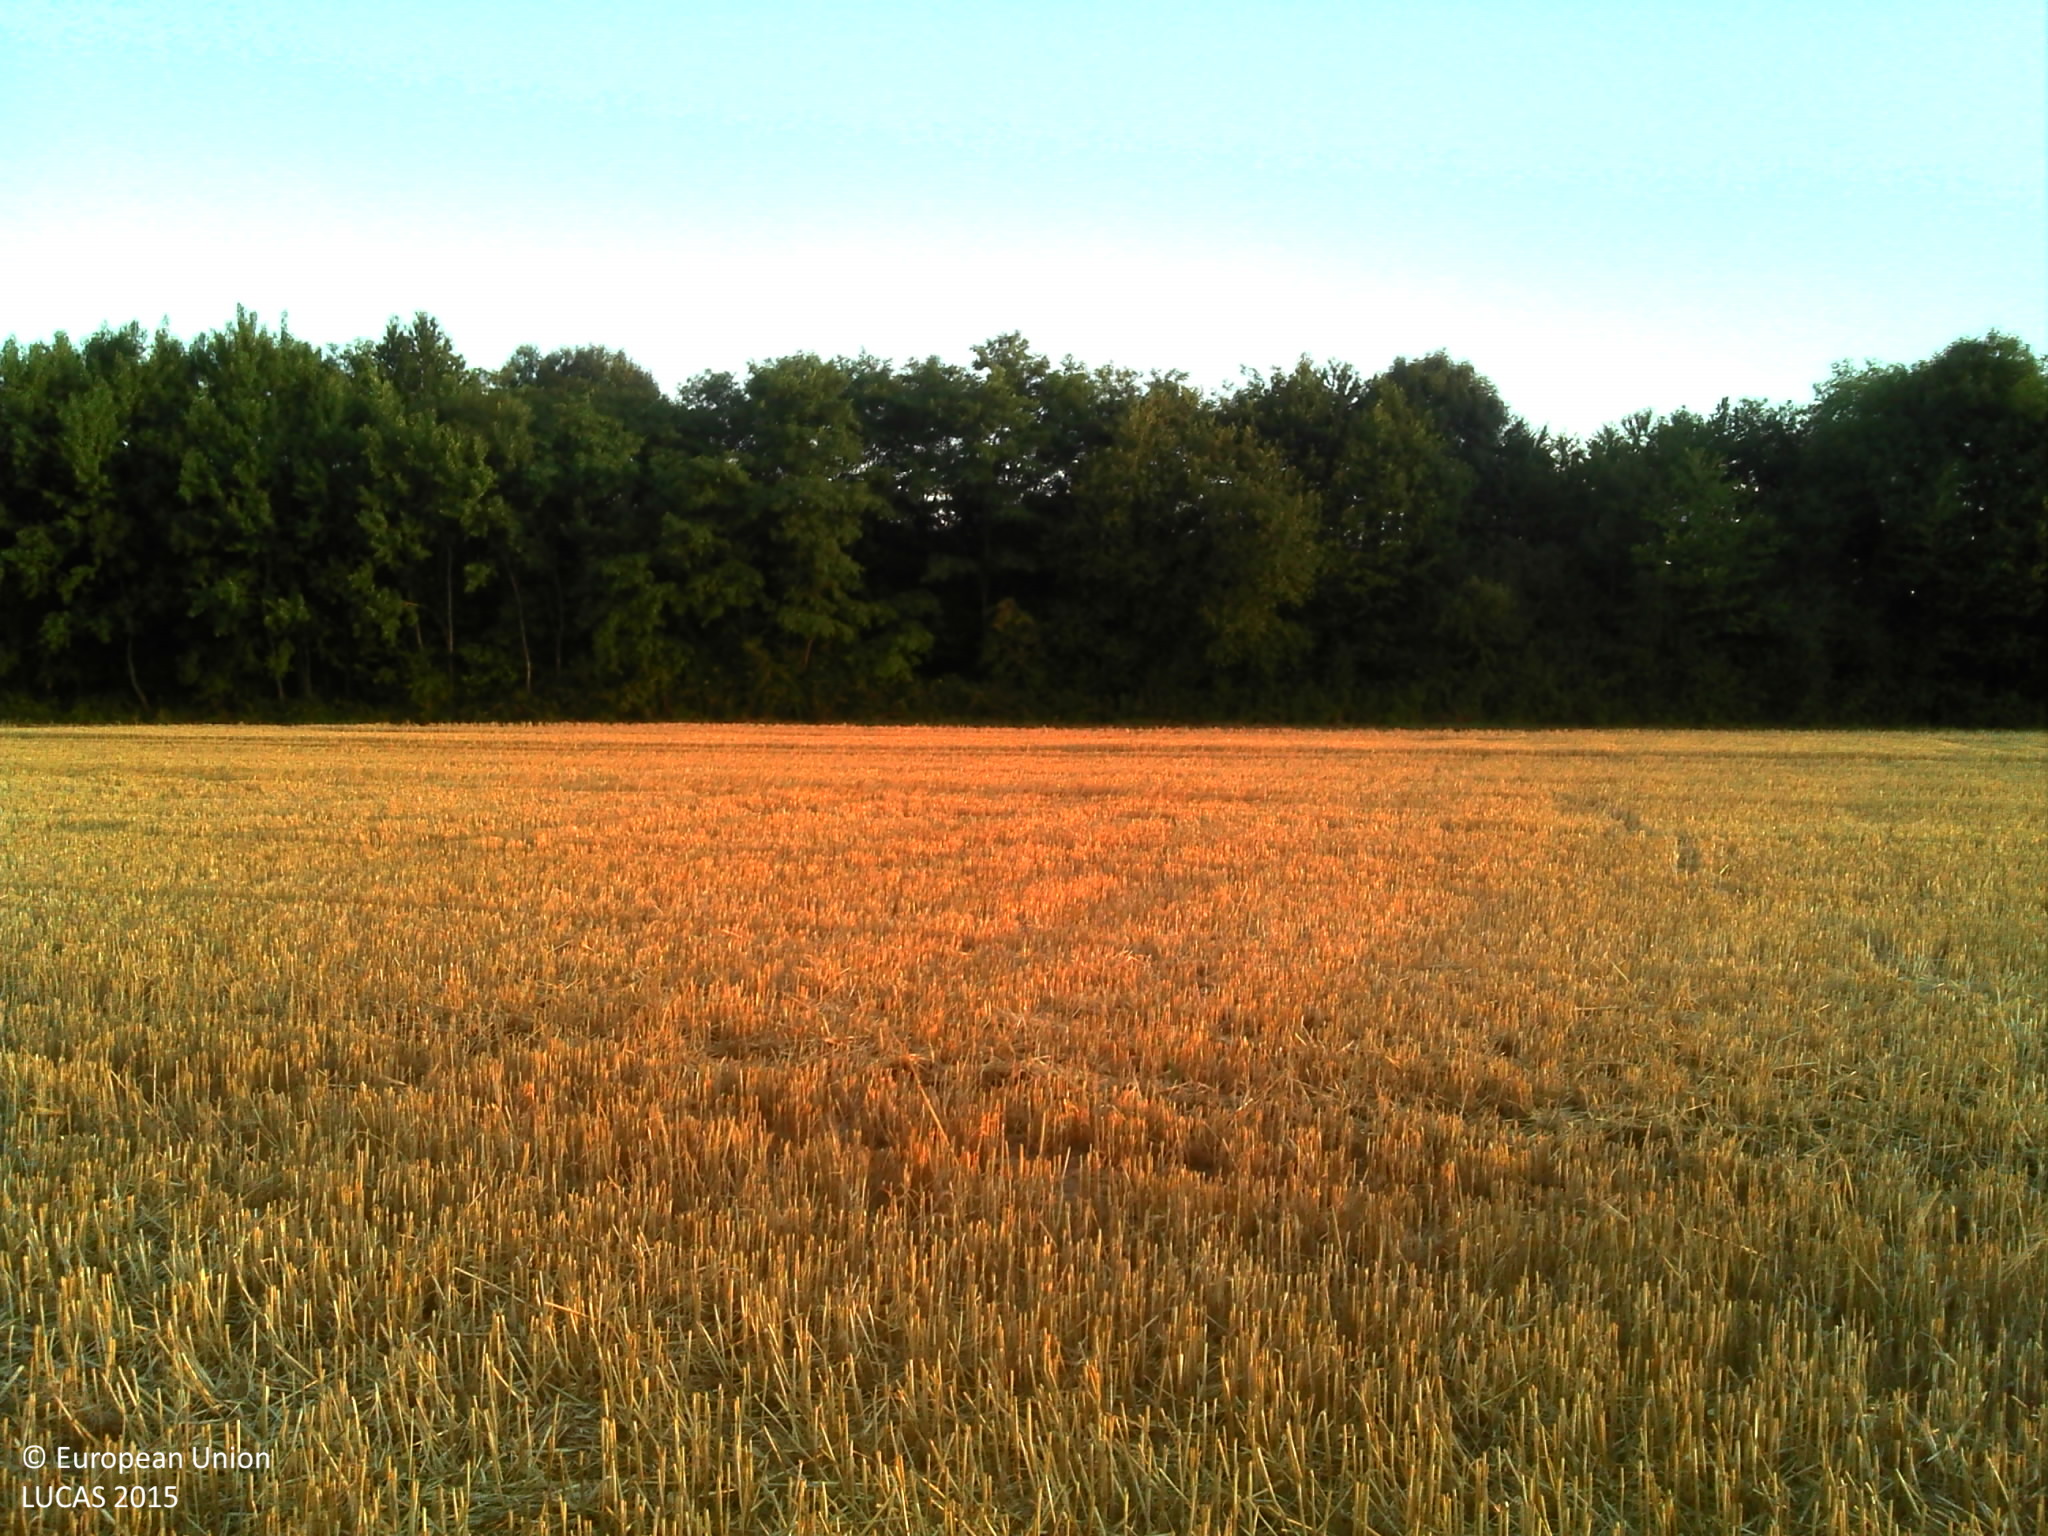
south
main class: Cropland
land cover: Barley
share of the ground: > 75 %
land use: Agriculture (excluding fallow land and kitchen gardens)
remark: Harvested field
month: July
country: FR
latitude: 48.5962
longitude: 0.9892
